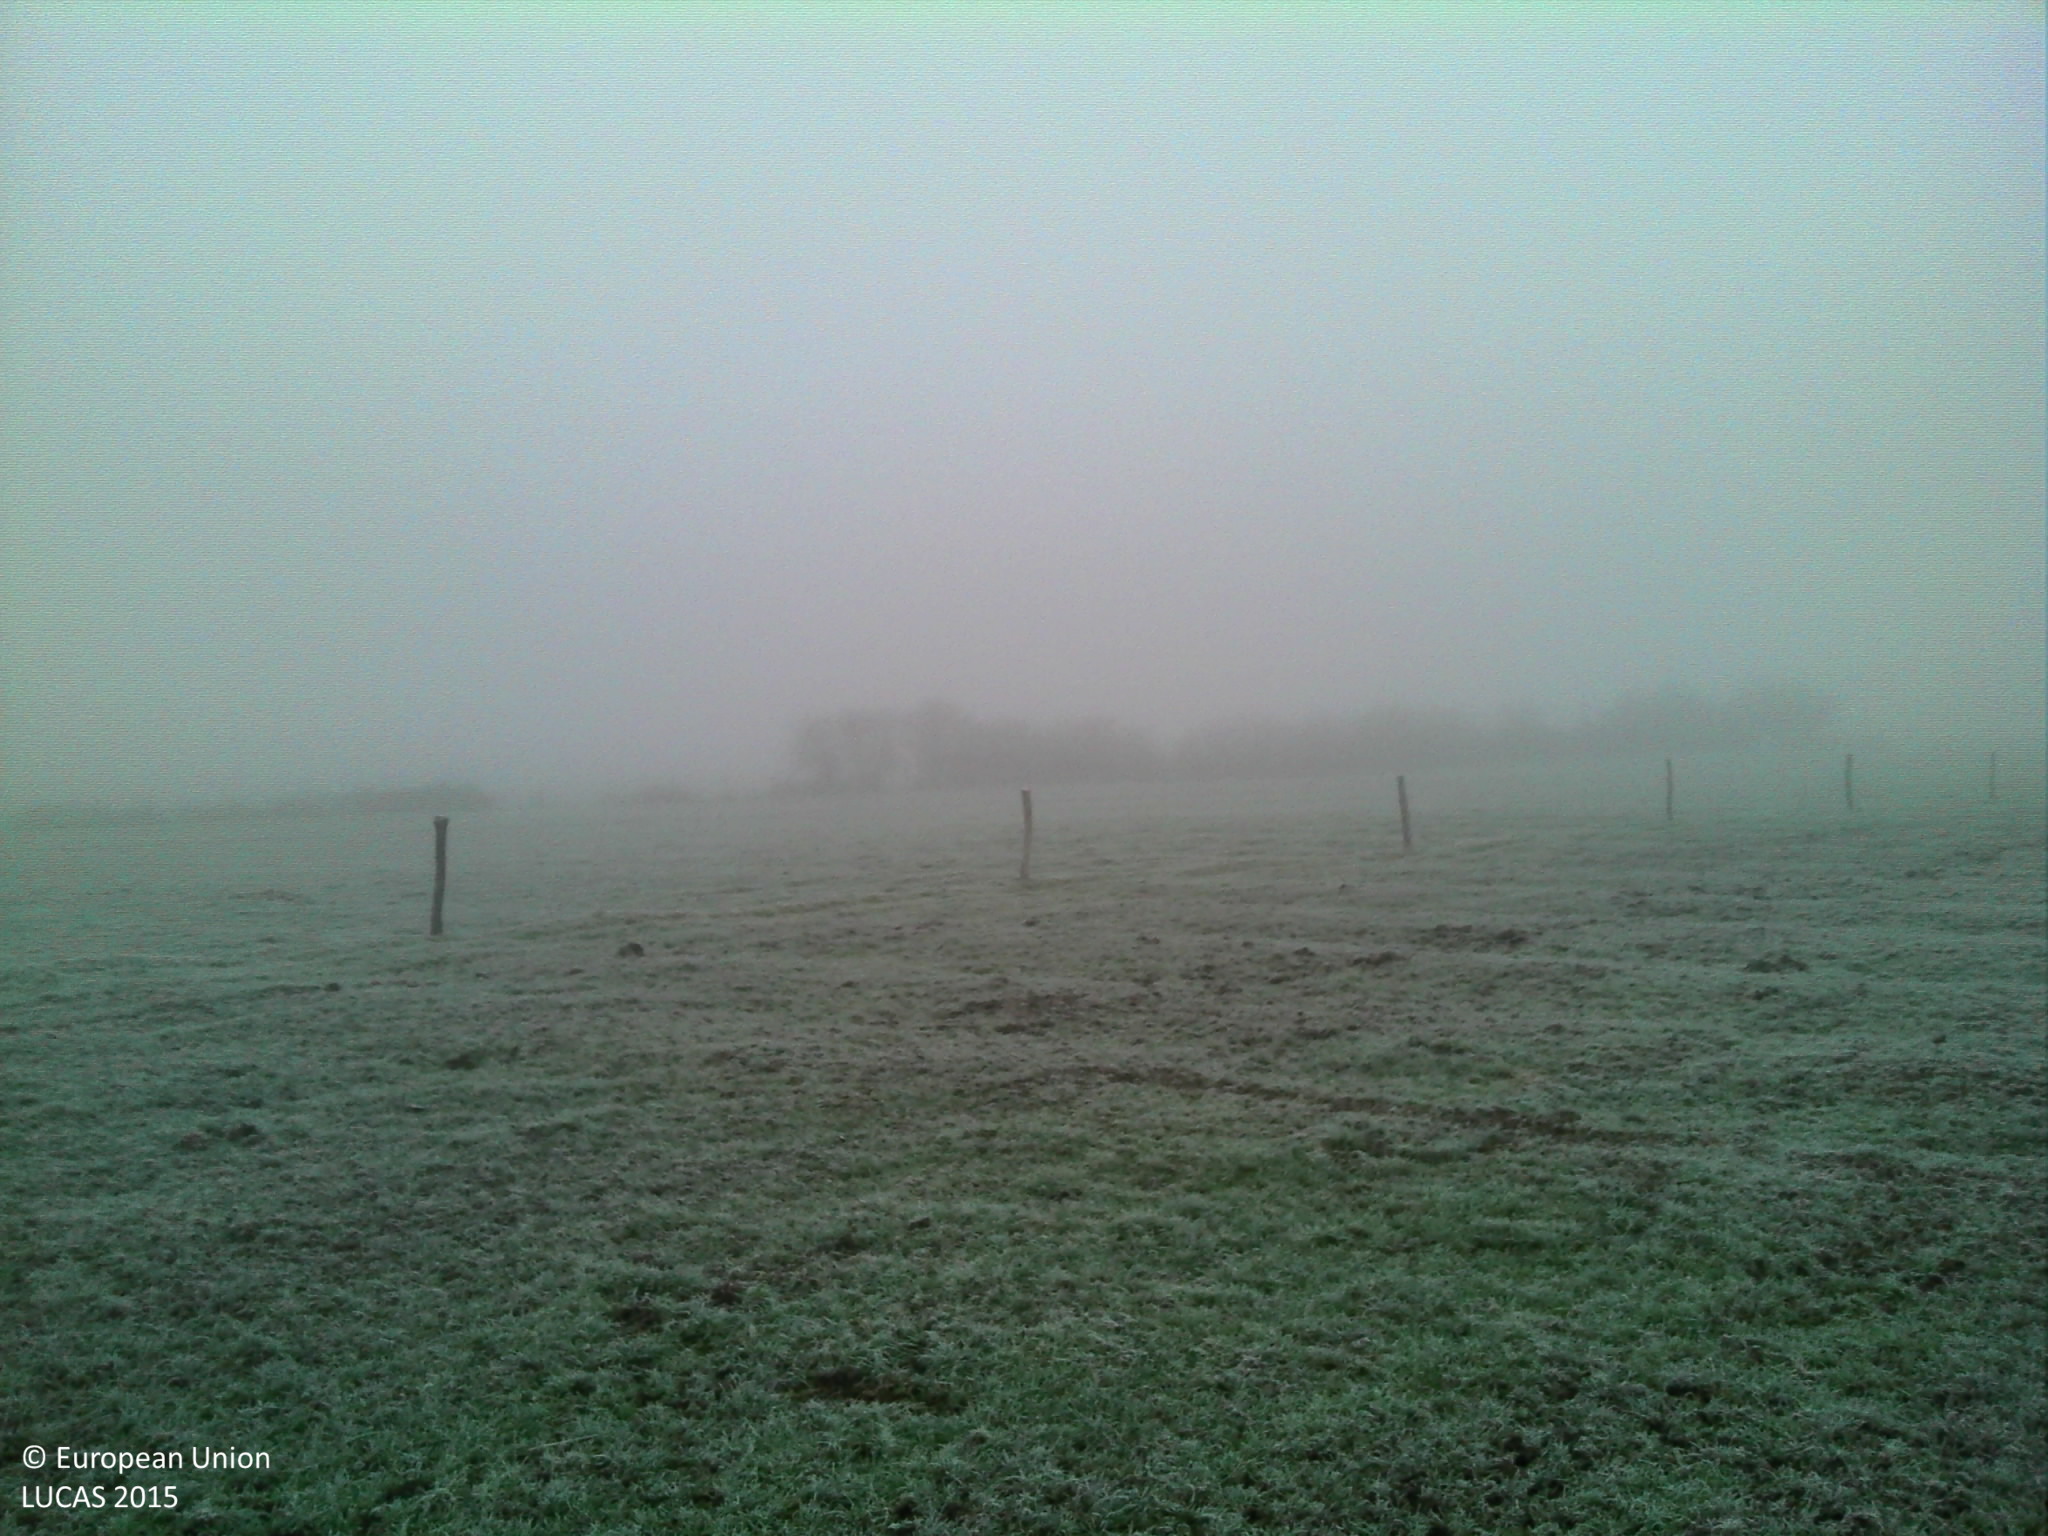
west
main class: Grassland
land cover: Grassland without tree/shrub cover
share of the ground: > 75 %
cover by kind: herbaceous plants 100 %
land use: Agriculture (excluding fallow land and kitchen gardens)
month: November
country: FR
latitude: 46.5925
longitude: 3.5902
